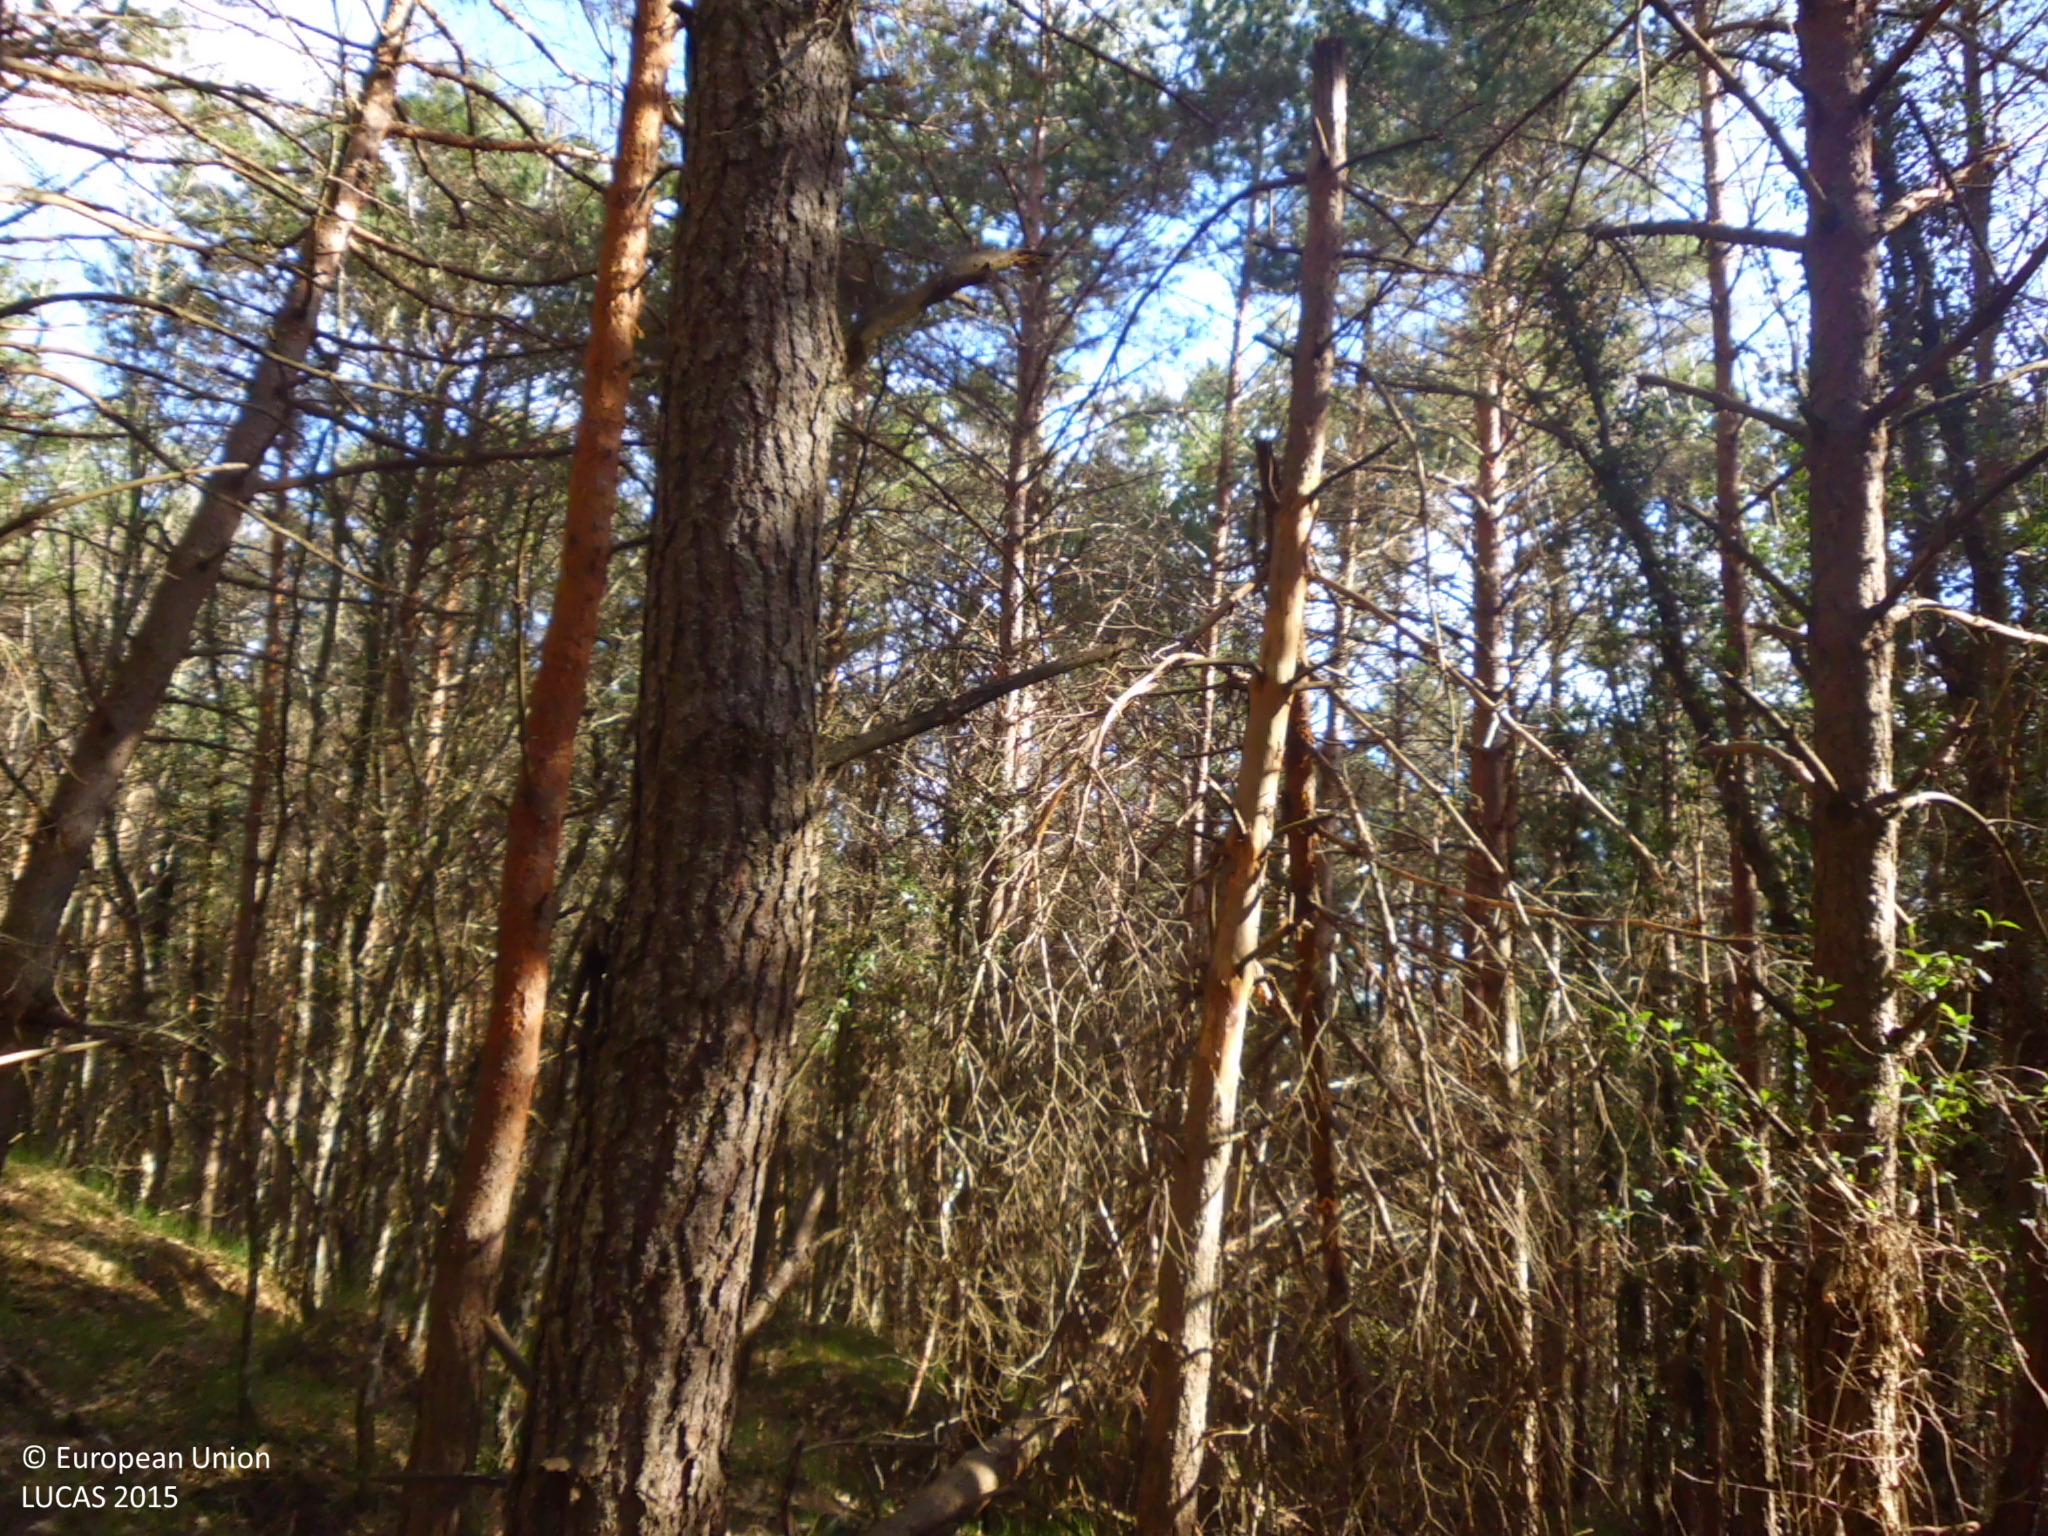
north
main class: Woodland
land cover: Pine dominated coniferous woodland
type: coniferous forest of the mediterranean region
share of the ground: > 75 %
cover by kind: coniferous forest trees 100 %
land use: Forestry
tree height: > 5 m
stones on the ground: < 10 %
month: April
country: ES
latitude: 42.3801
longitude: -3.4043
